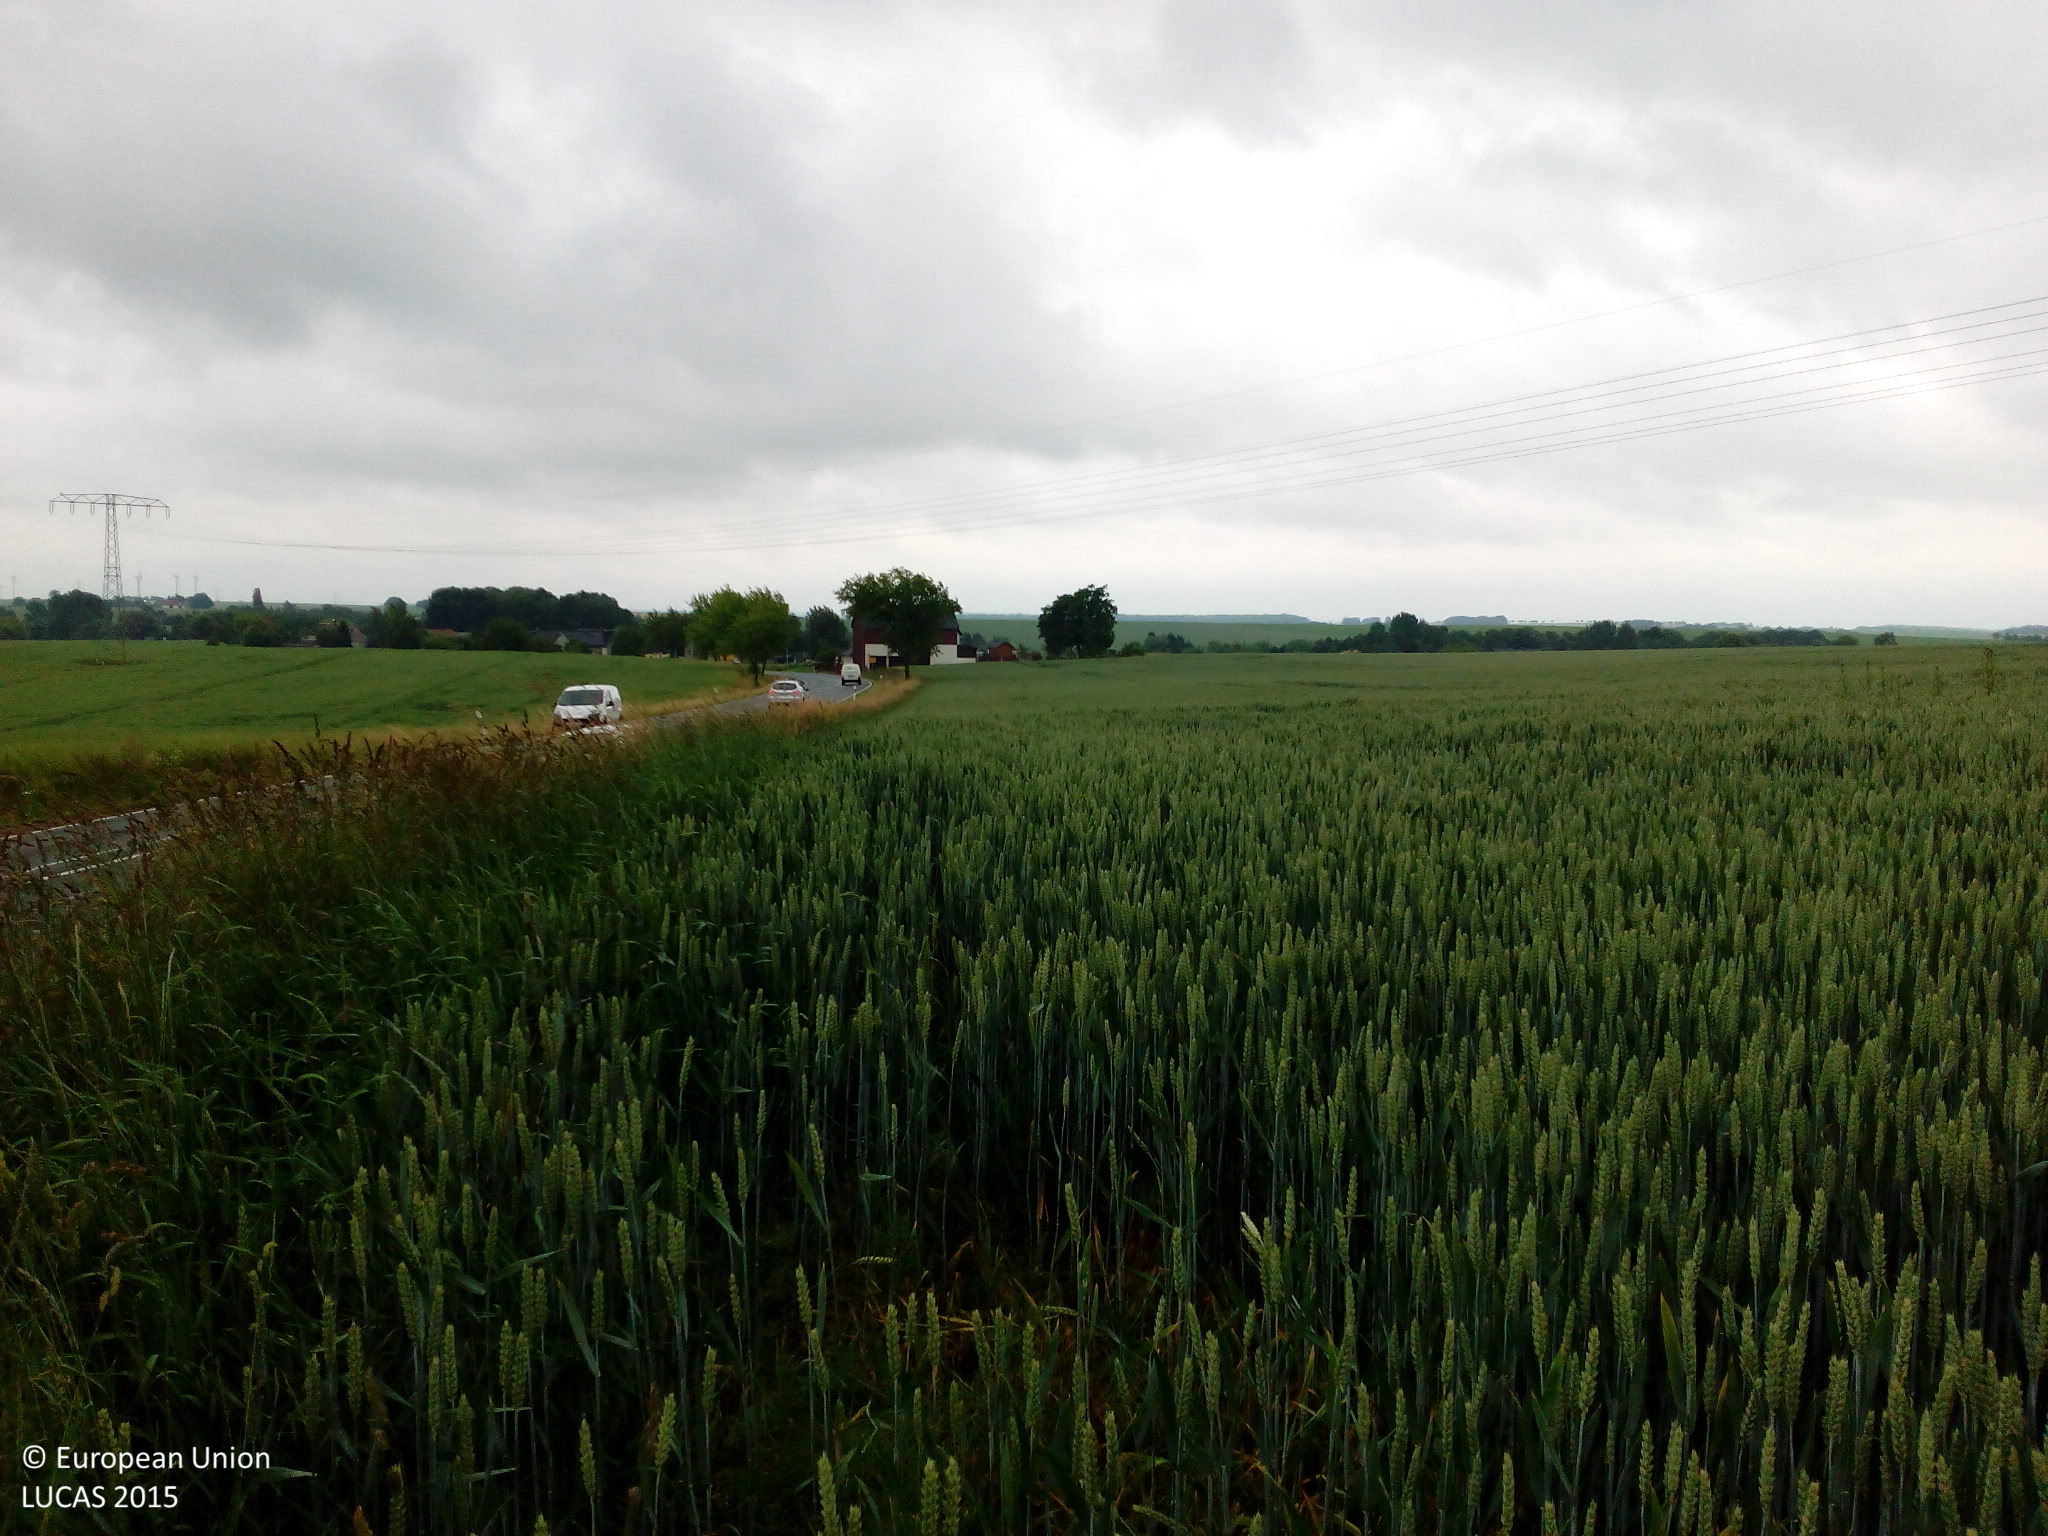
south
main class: Cropland
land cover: Common wheat
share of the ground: > 75 %
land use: Agriculture (excluding fallow land and kitchen gardens)
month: June
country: DE
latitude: 51.0958
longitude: 13.0987
